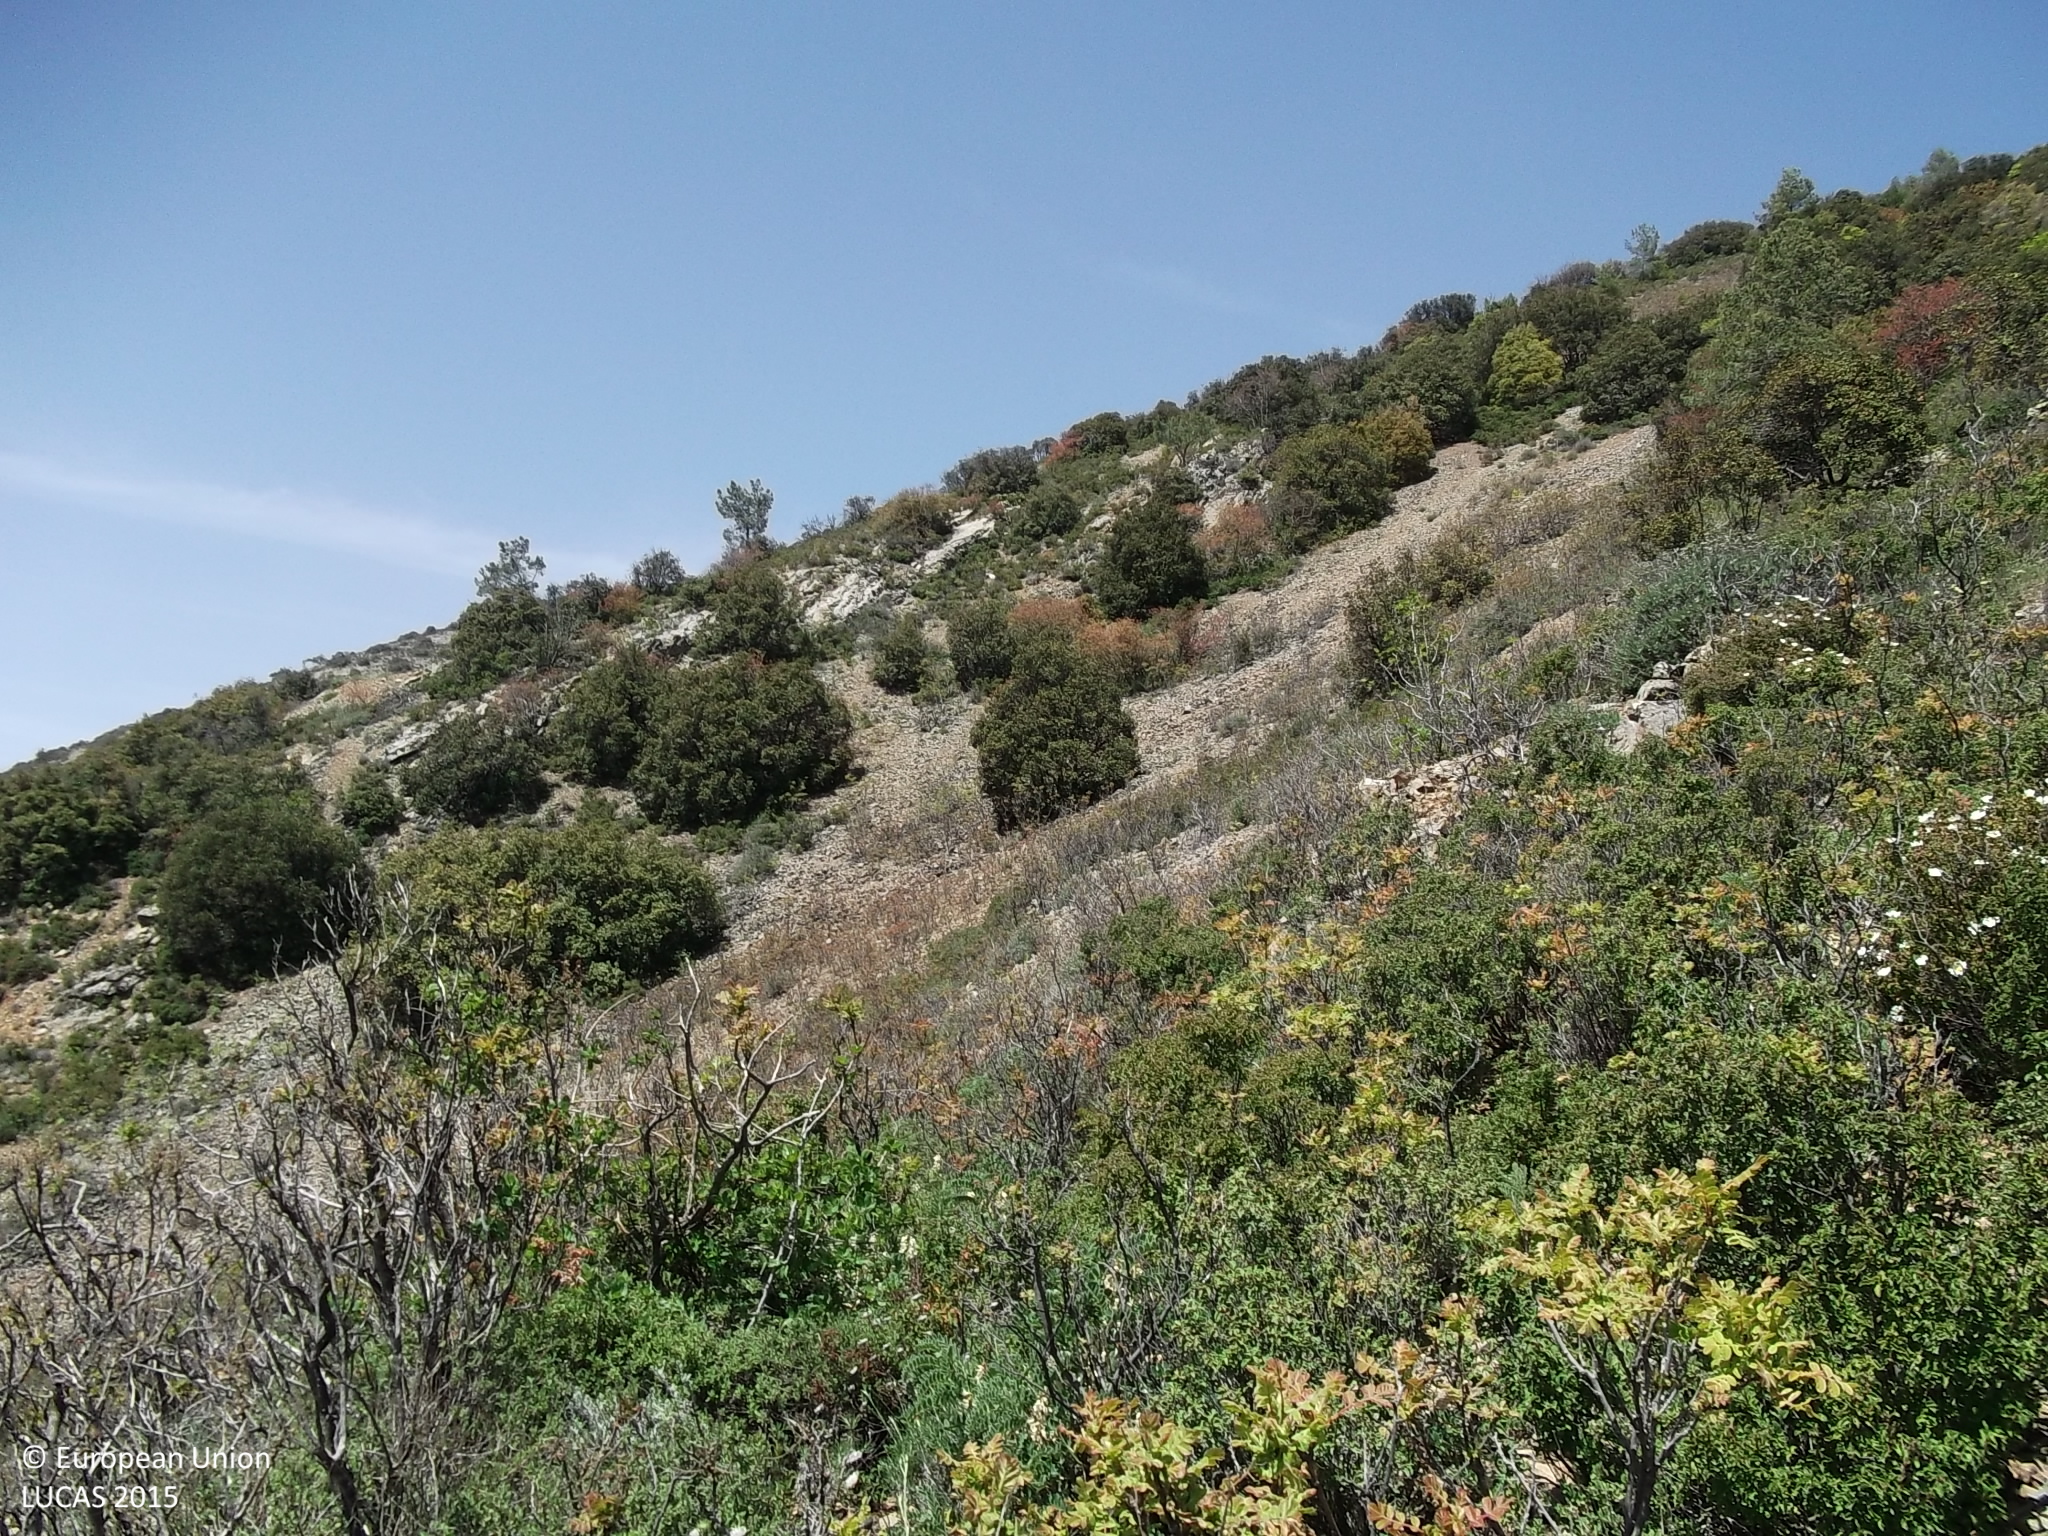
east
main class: Shrubland
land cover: Shrubland without tree cover
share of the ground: > 75 %
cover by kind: shrubs 75 %, consolidated bare surface 15 %, unconsolidated bare surface 10 %
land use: Semi-natural and natural areas not in use
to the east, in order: Shrubland without tree cover; Other bare soil; Shrubland without tree cover; Tracks; Broadleaved woodland
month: April
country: CY
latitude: 34.8951
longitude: 33.1906
